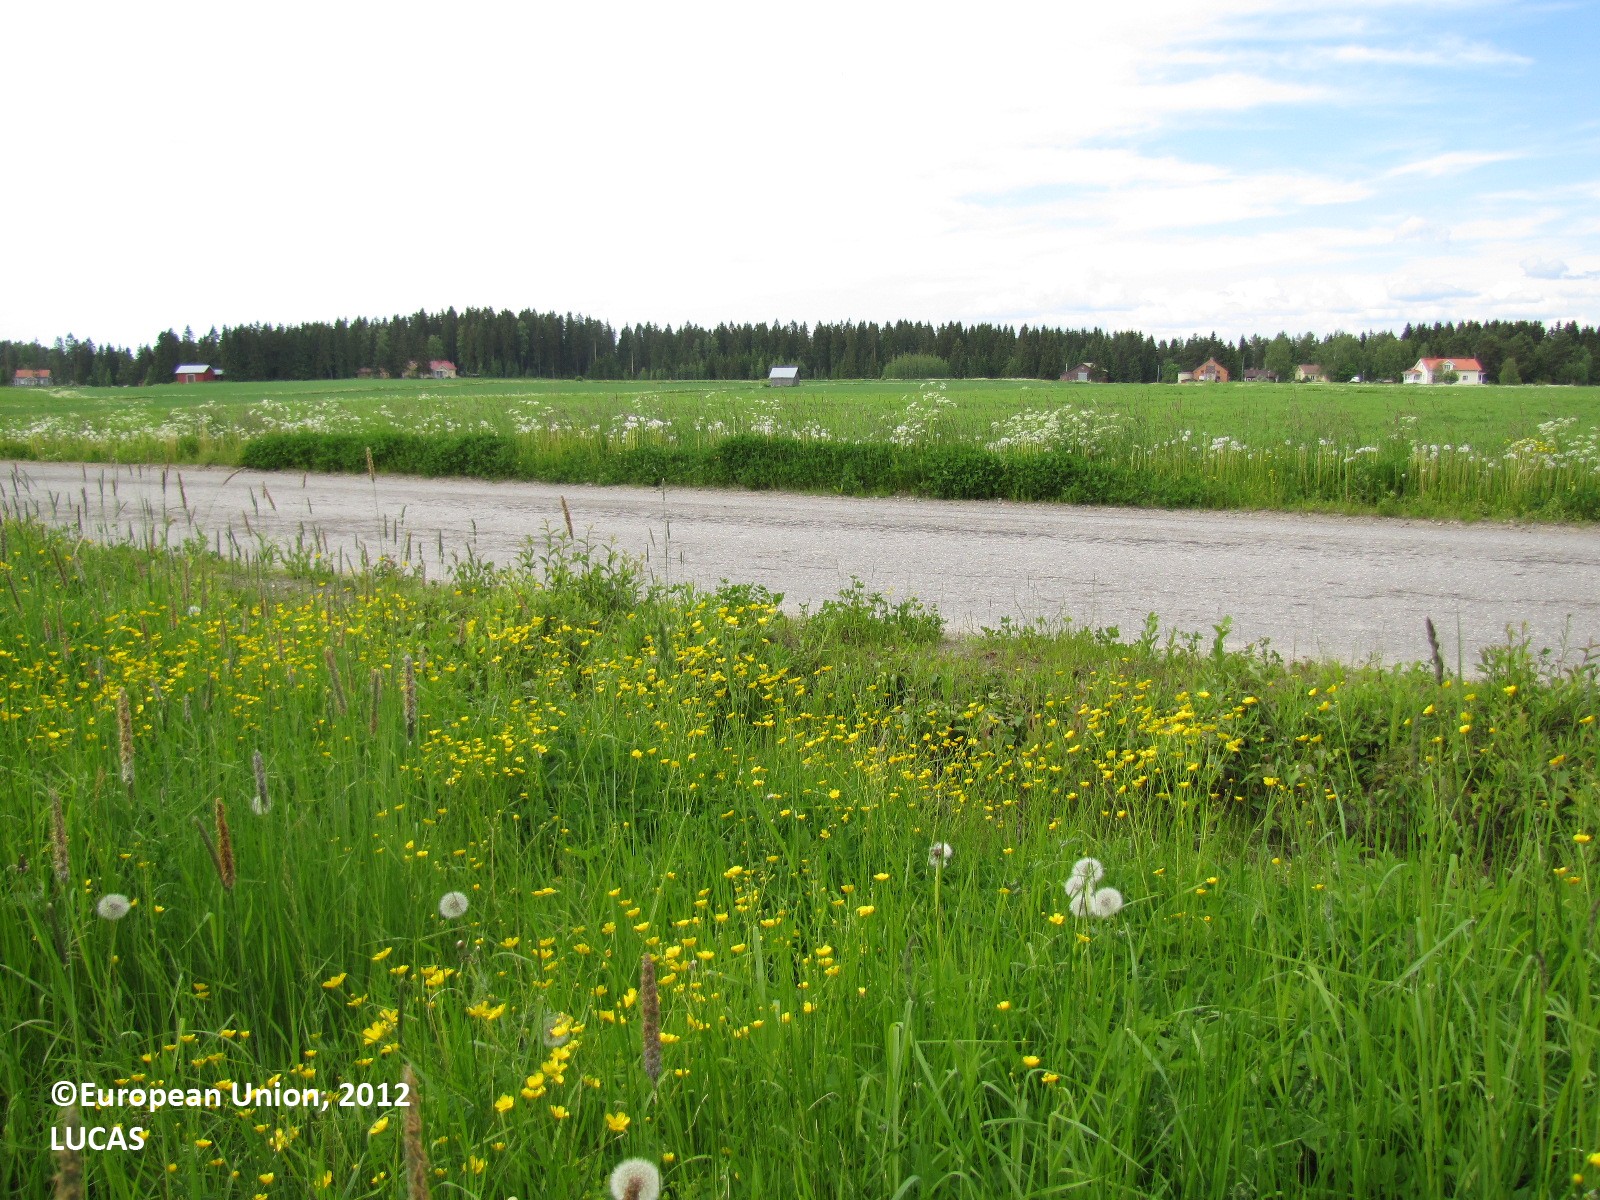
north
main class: Grassland
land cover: Grassland without tree/shrub cover
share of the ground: > 75 %
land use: Residential
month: June
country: FI
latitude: 61.4830
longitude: 24.3086
